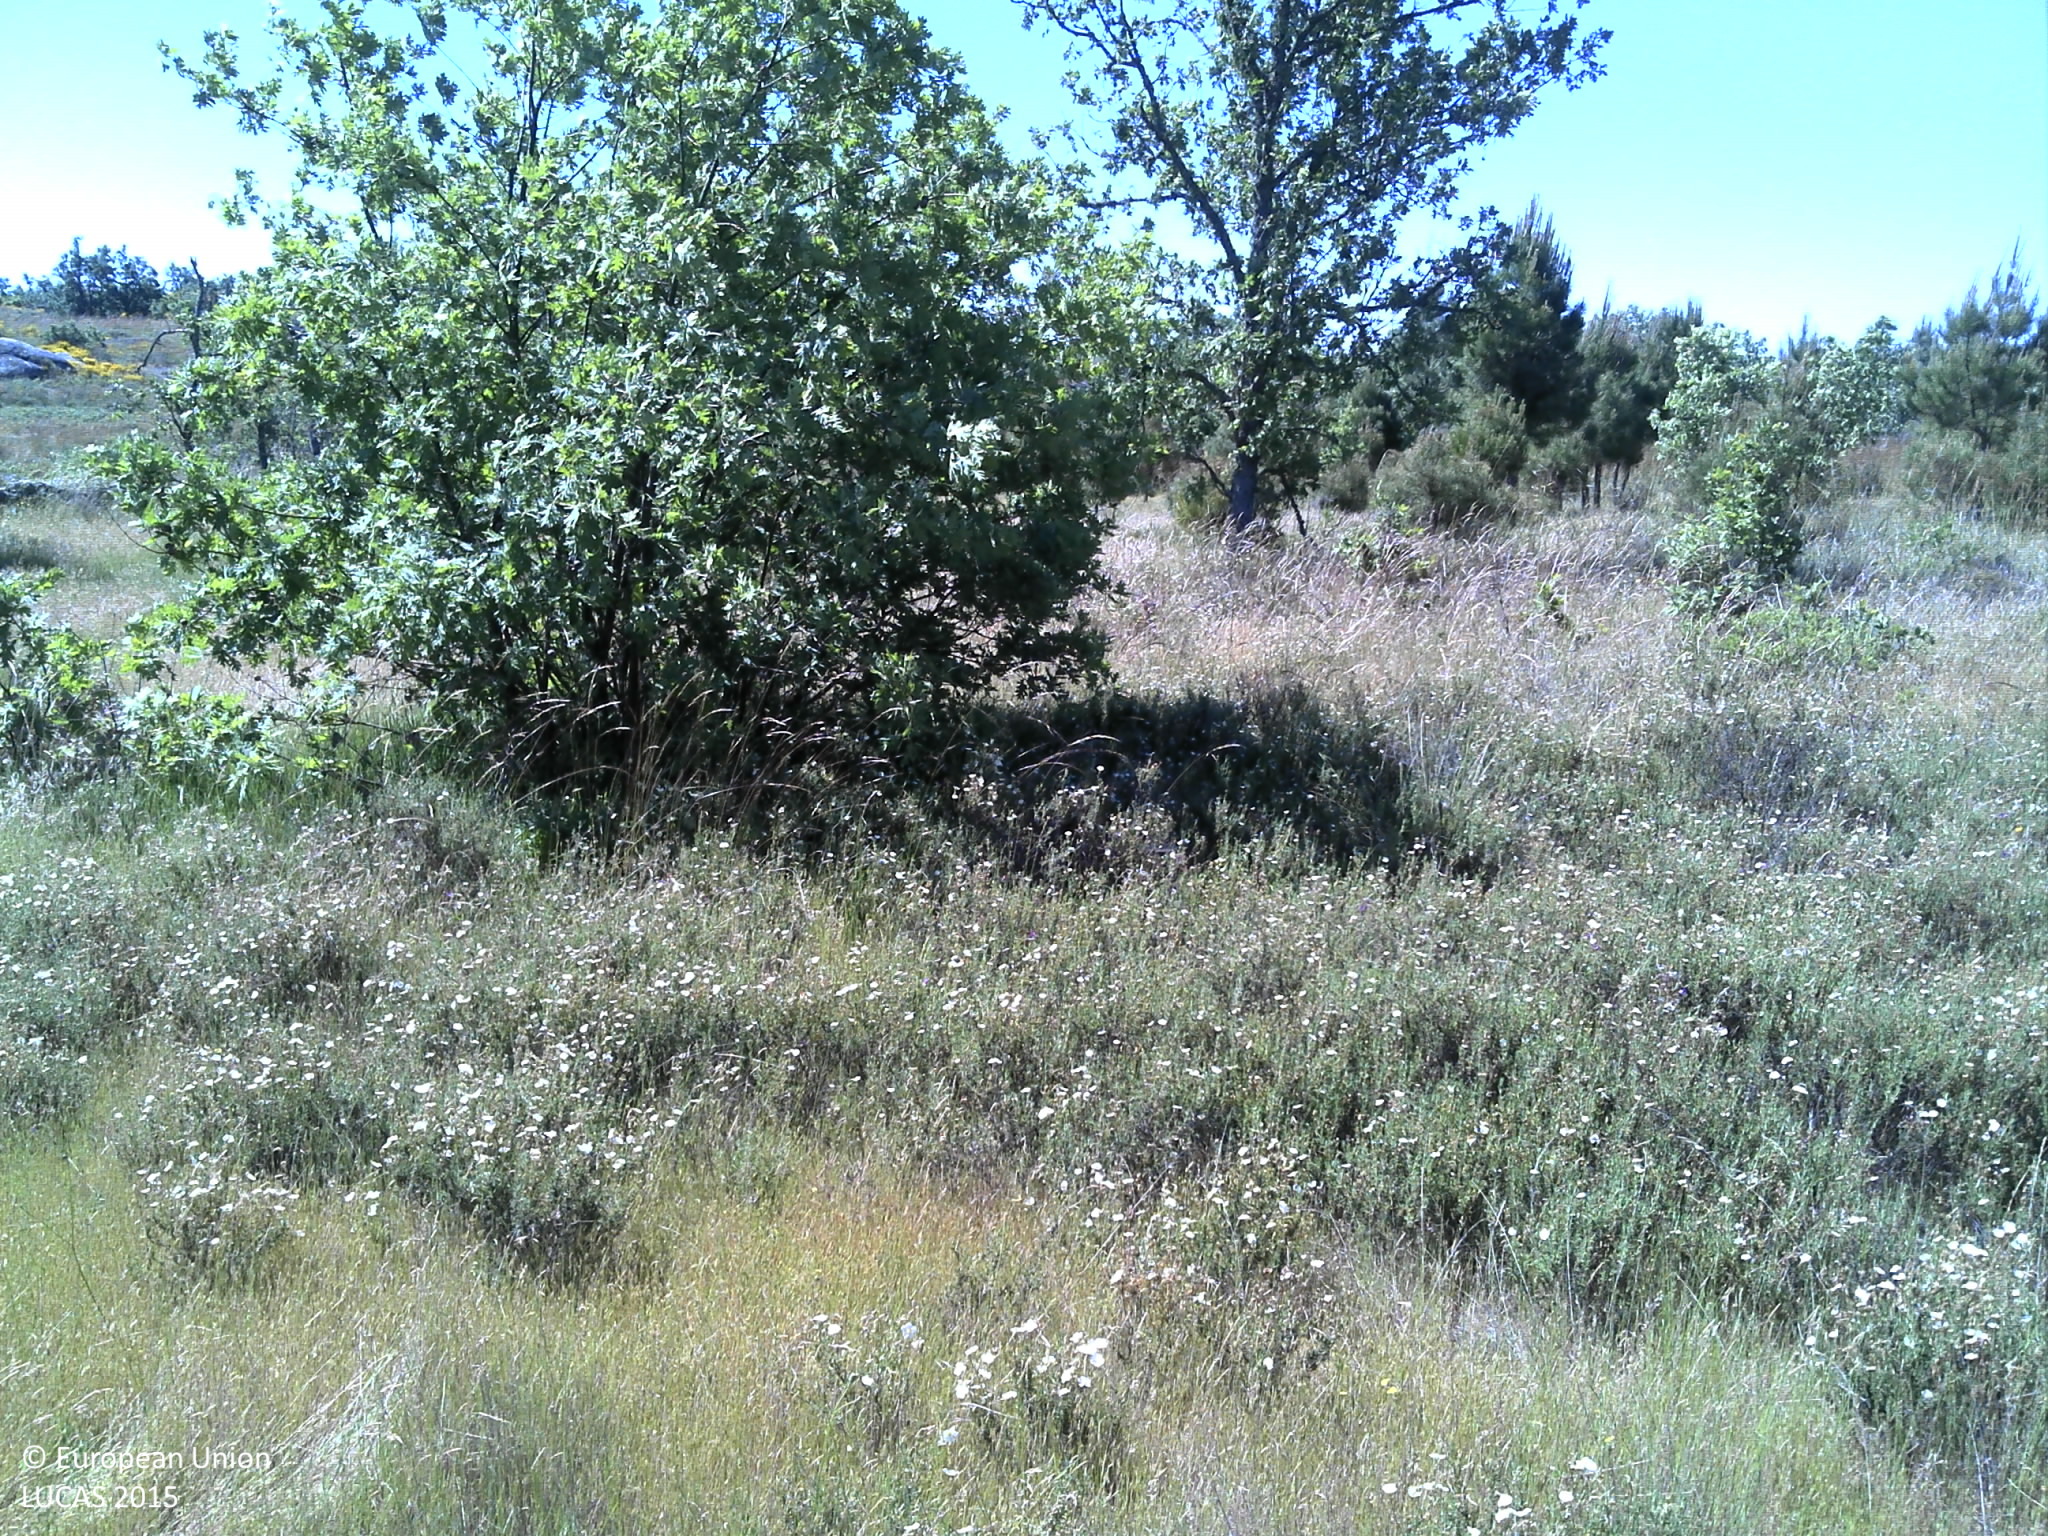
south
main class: Grassland
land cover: Grassland with sparse tree/shrub cover
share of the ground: > 75 %
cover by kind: herbaceous plants 95 %, broadleaved forest trees 5 %
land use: Agriculture (excluding fallow land and kitchen gardens)
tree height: > 5 m
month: May
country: PT
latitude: 41.3572
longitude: -6.5372
